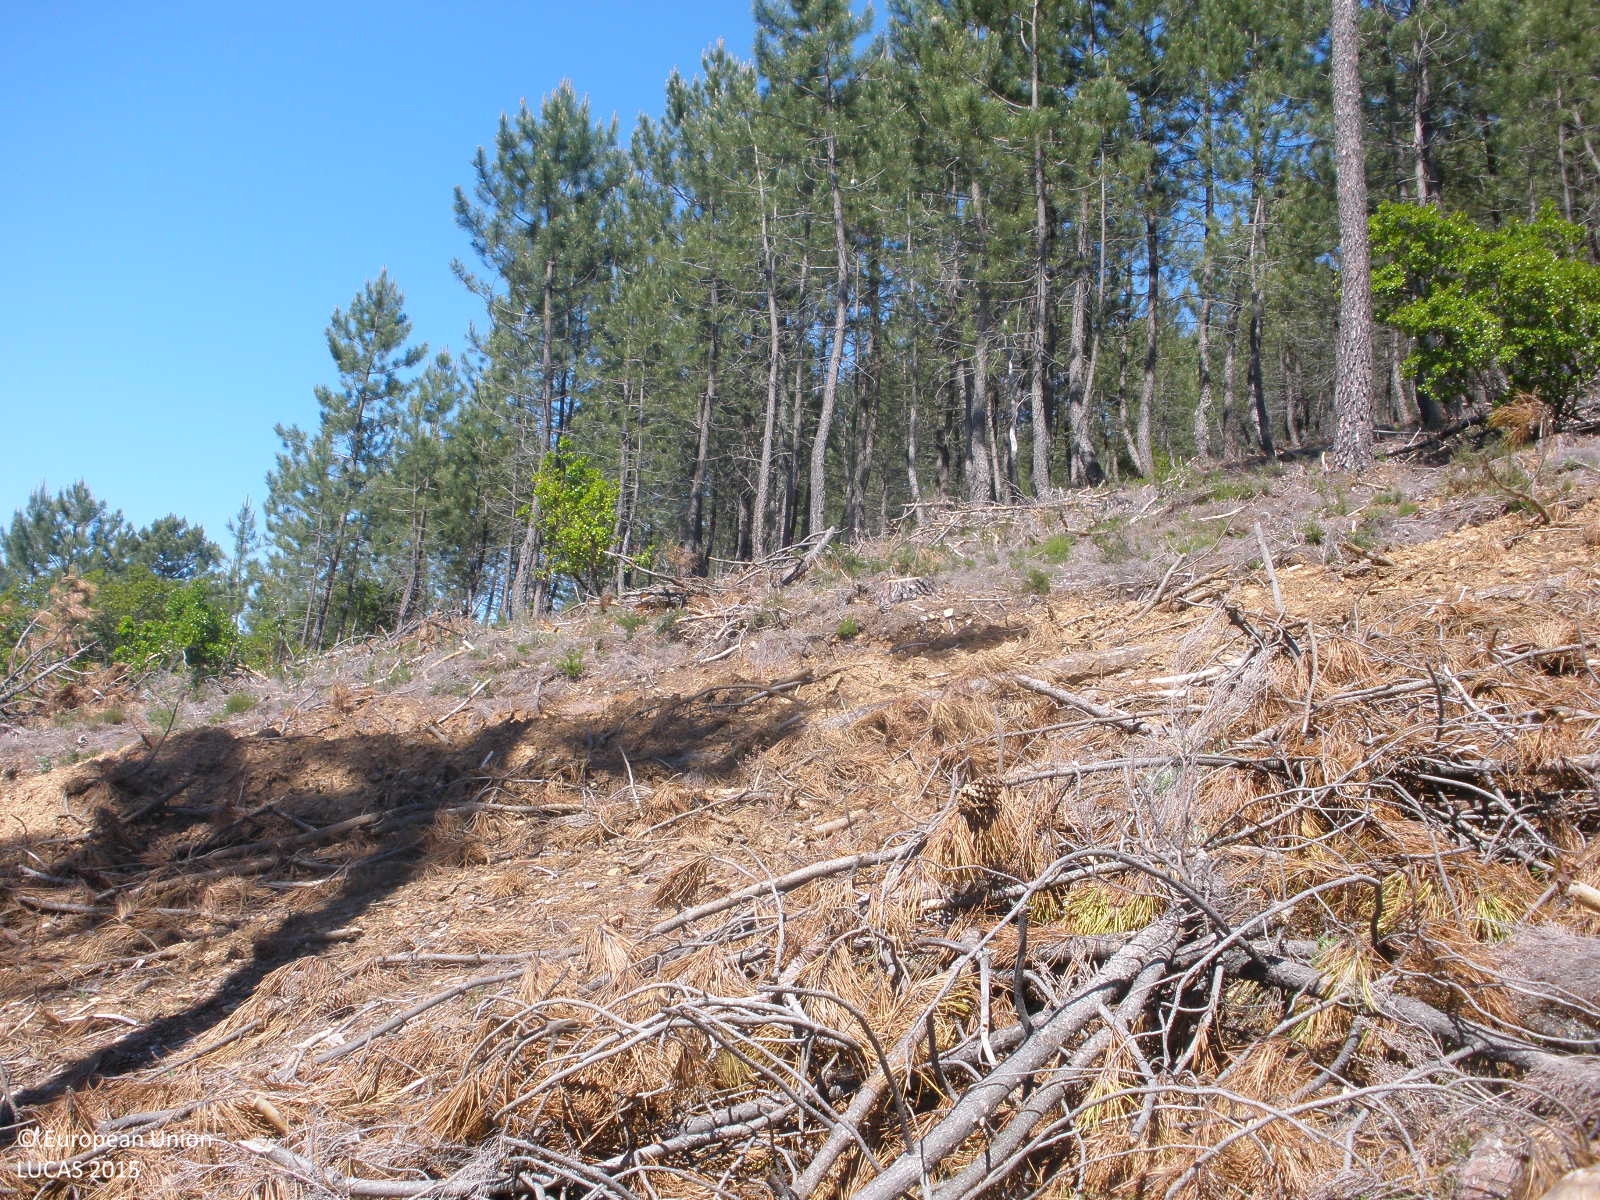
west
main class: Woodland
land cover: Pine dominated coniferous woodland
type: coniferous forest of the mediterranean region
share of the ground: > 75 %
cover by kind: coniferous forest trees 40 %, shrubs 30 %, consolidated bare surface 30 %
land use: Forestry
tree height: > 5 m
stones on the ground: < 10 %
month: May
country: ES
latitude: 40.4492
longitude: -6.2466
